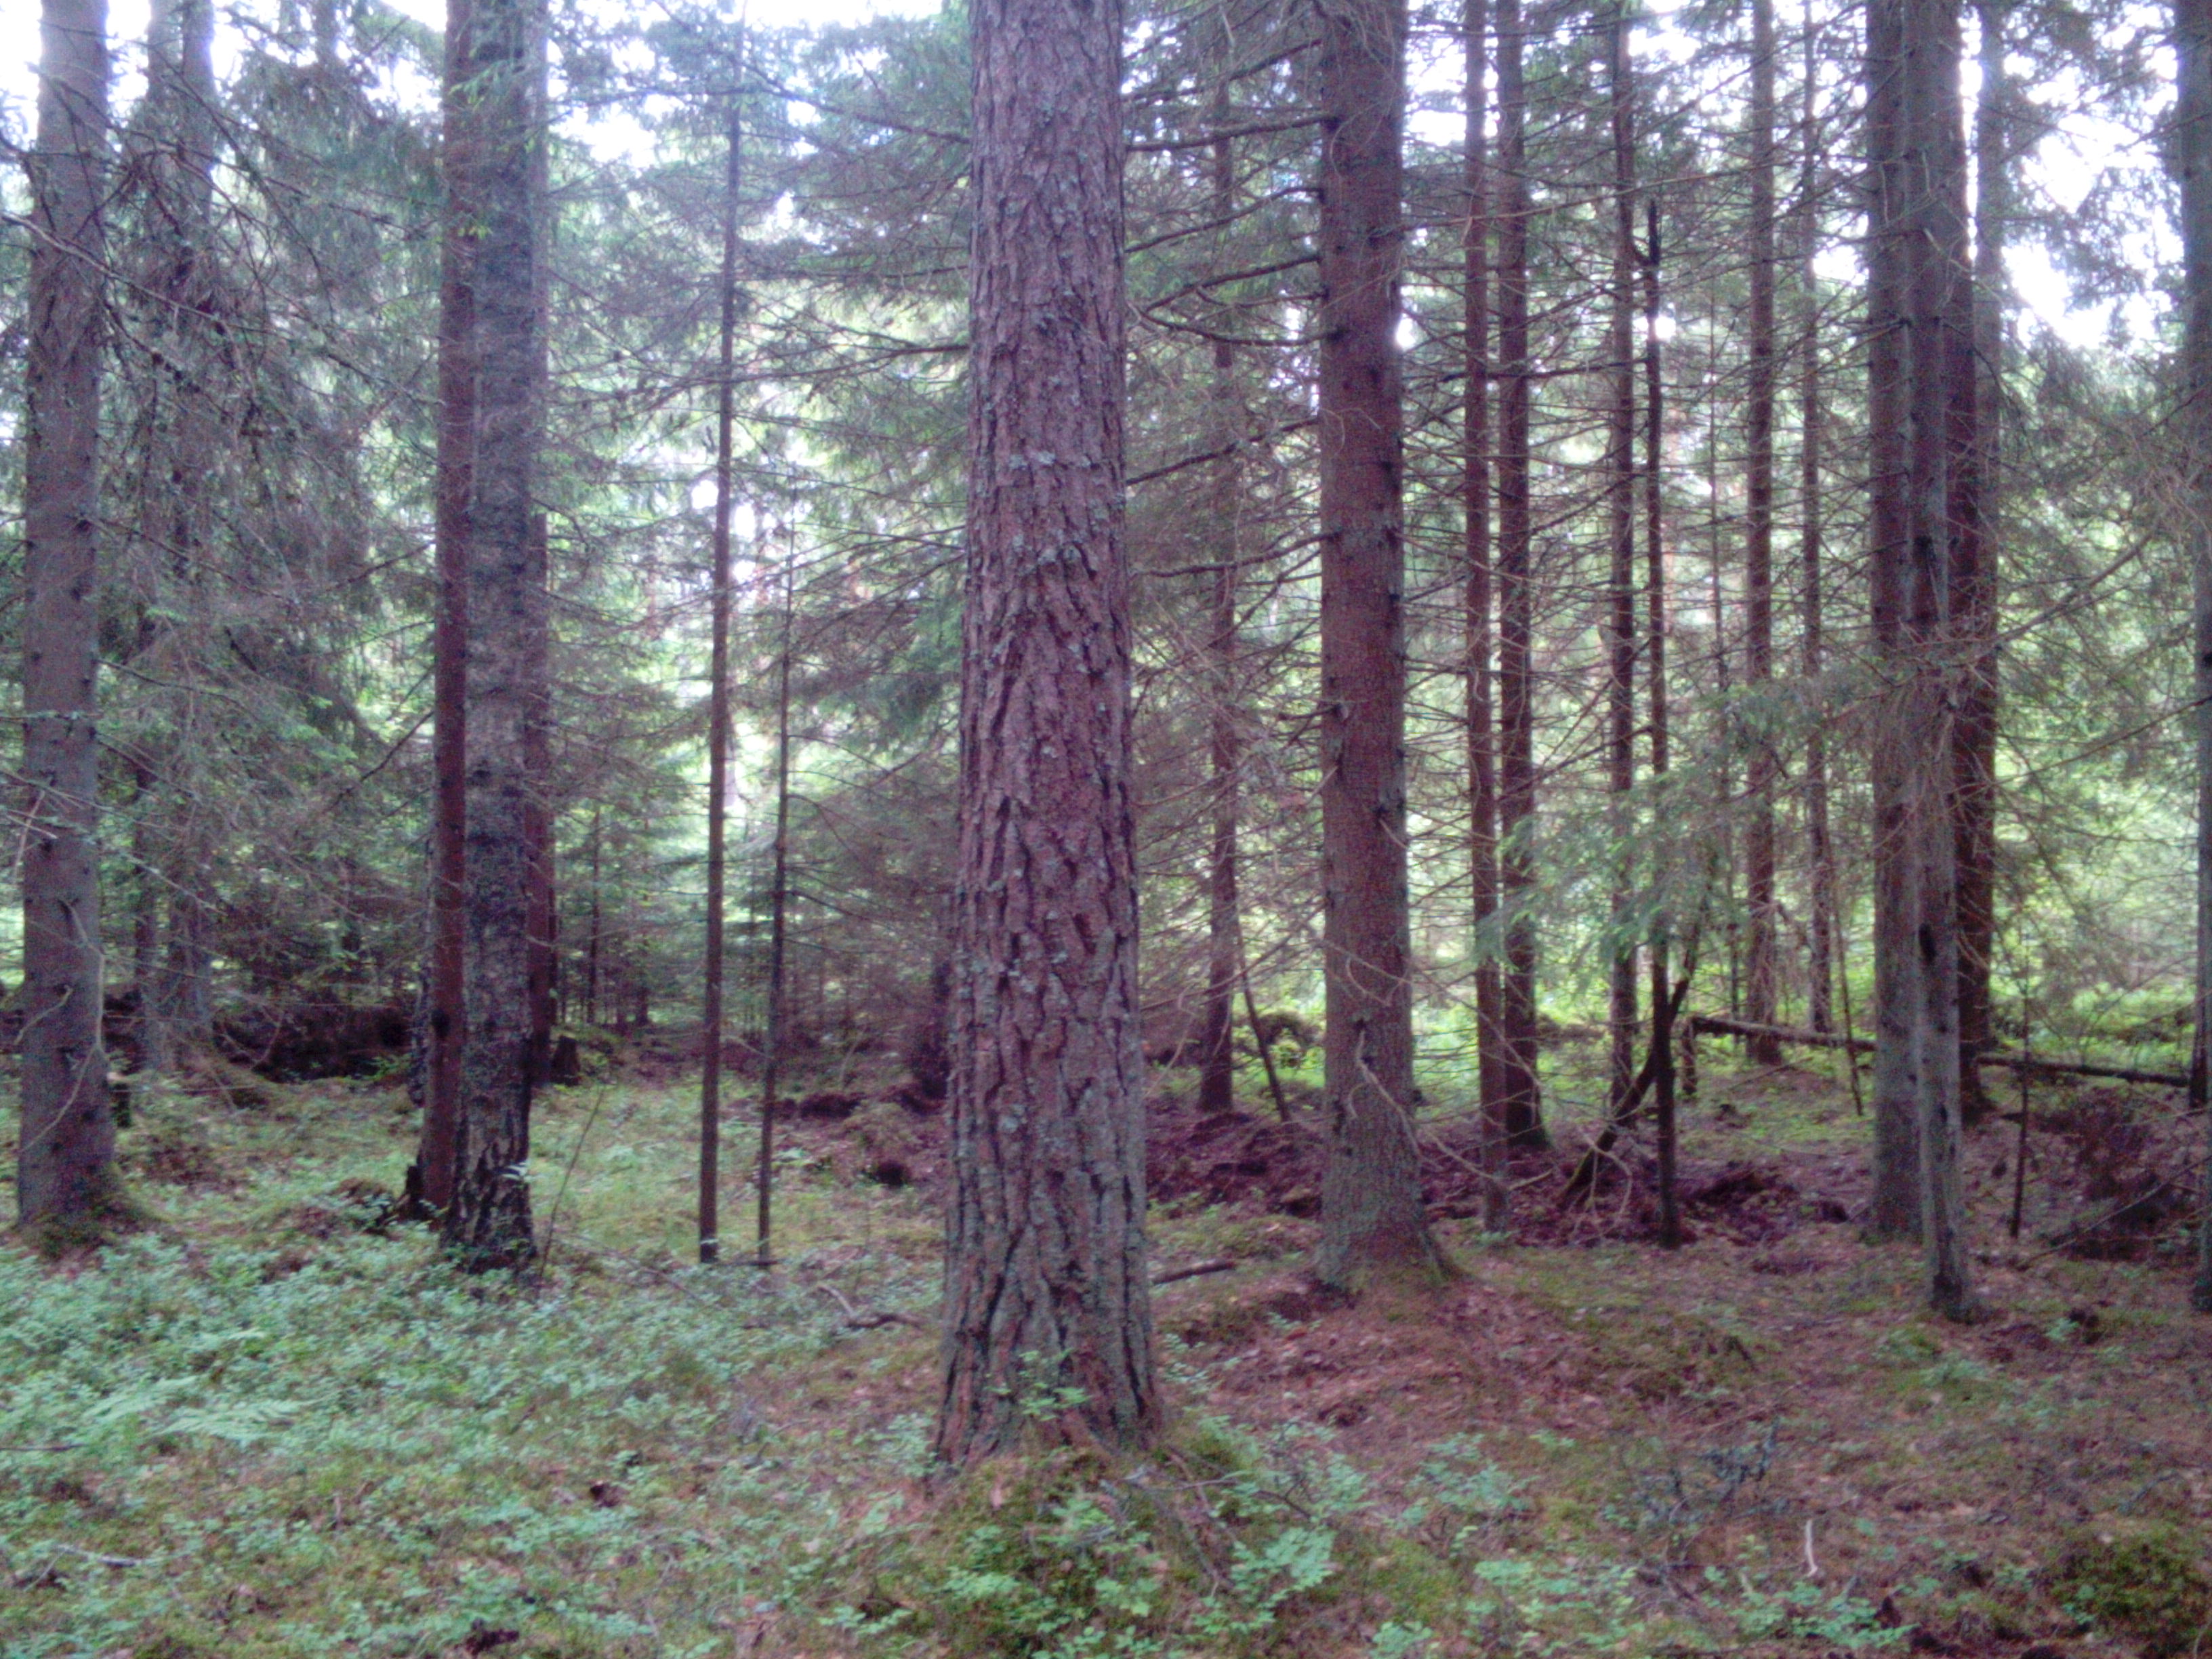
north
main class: Woodland
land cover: Other coniferous woodland
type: hemiboreal forest and nemoral coniferous forest and mixed broadleaved-coniferous forest
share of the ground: > 75 %
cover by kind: coniferous forest trees 90 %, herbaceous plants 5 %, lichens and mosses 5 %
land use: Forestry
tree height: > 5 m
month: June
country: LV
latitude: 56.9626
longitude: 21.4701
